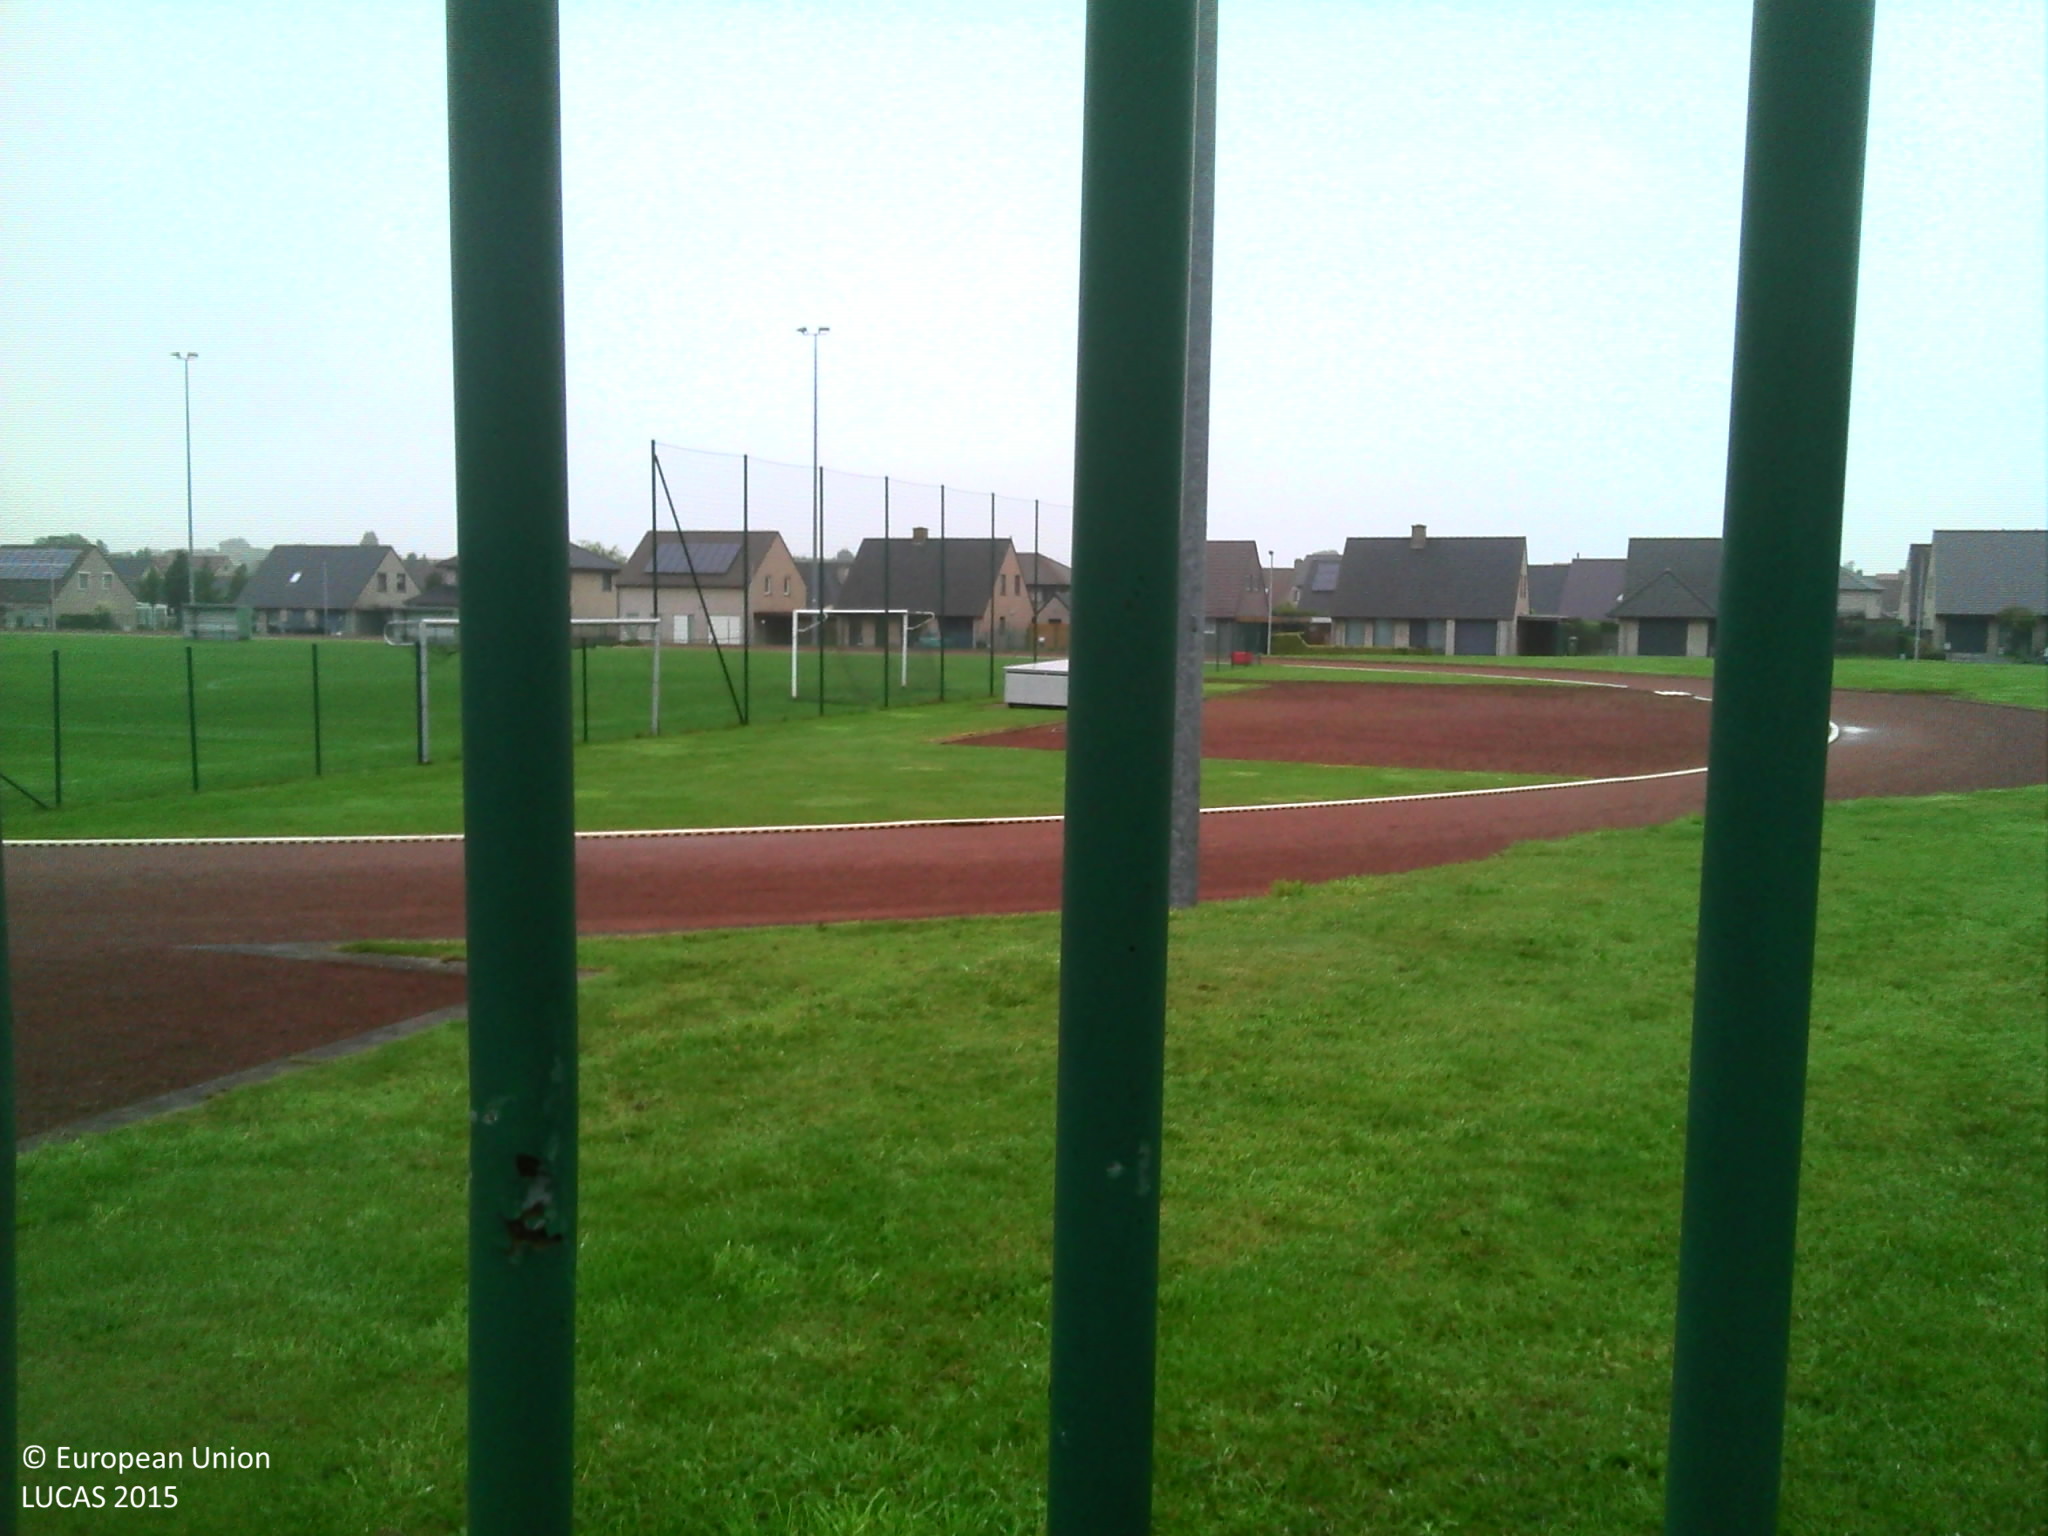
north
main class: Grassland
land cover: Grassland without tree/shrub cover
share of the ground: > 75 %
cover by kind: herbaceous plants 100 %
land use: Sport
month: October
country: BE
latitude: 51.0262
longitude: 2.8746
